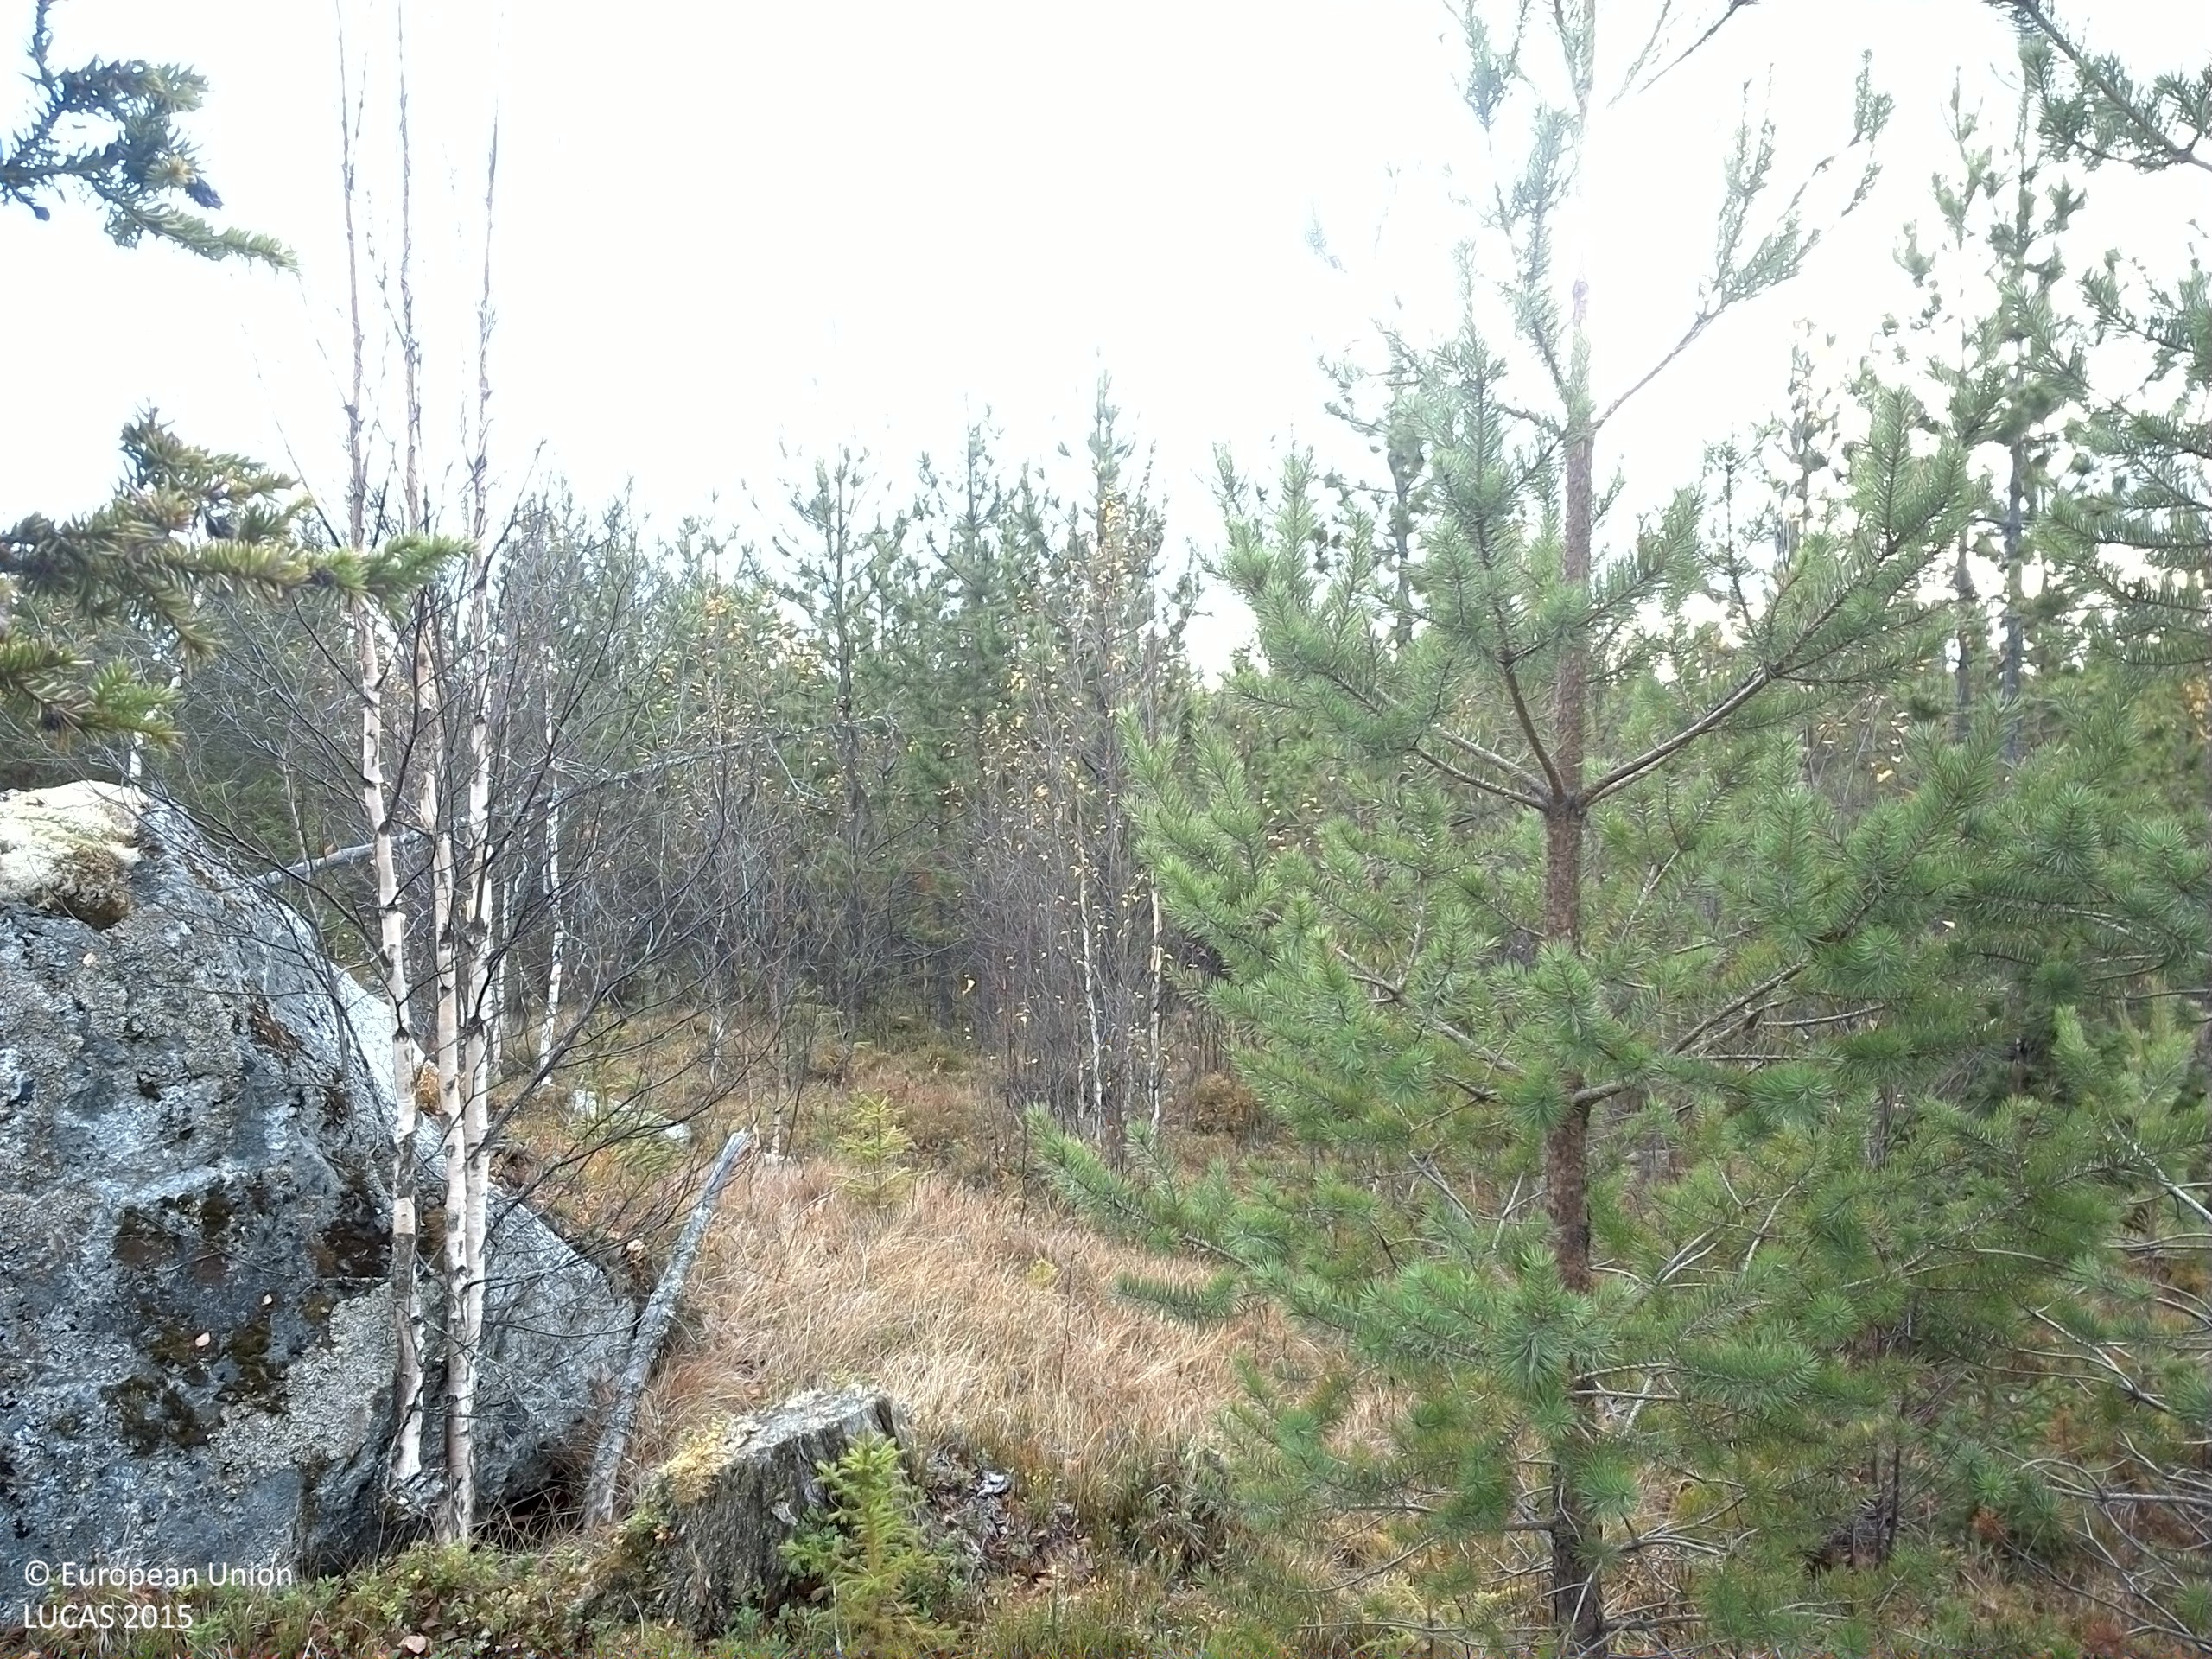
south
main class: Woodland
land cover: Spruce dominated mixed woodland
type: boreal forest
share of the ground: 25 - 50 %
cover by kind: shrubs 40 %, broadleaved forest trees 15 %, lichens and mosses 15 %, coniferous forest trees 10 %, herbaceous plants 10 %, consolidated bare surface 10 %
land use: Forestry
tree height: < 5 m
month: October
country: SE
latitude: 64.0159
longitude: 15.9248
